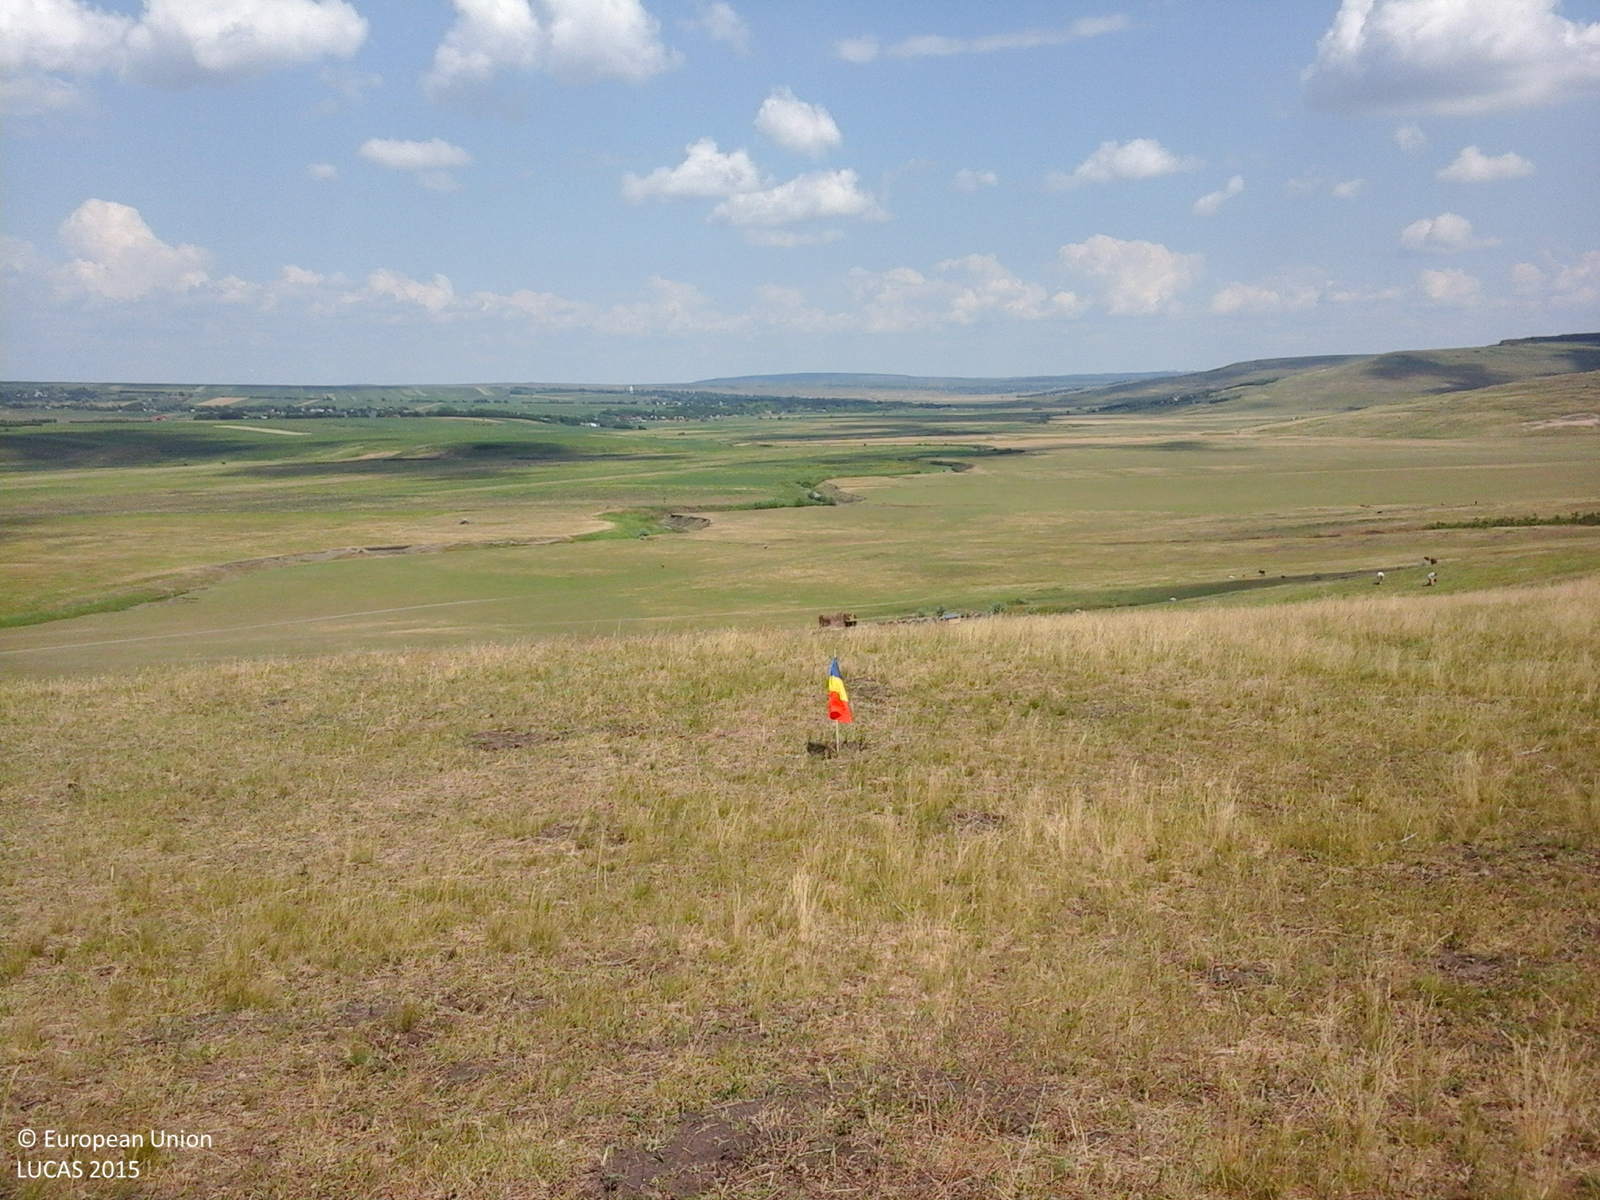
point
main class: Grassland
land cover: Grassland without tree/shrub cover
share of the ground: > 75 %
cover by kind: herbaceous plants 100 %
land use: Agriculture (excluding fallow land and kitchen gardens)
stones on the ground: < 10 %
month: June
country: RO
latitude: 47.6014
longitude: 27.0368
